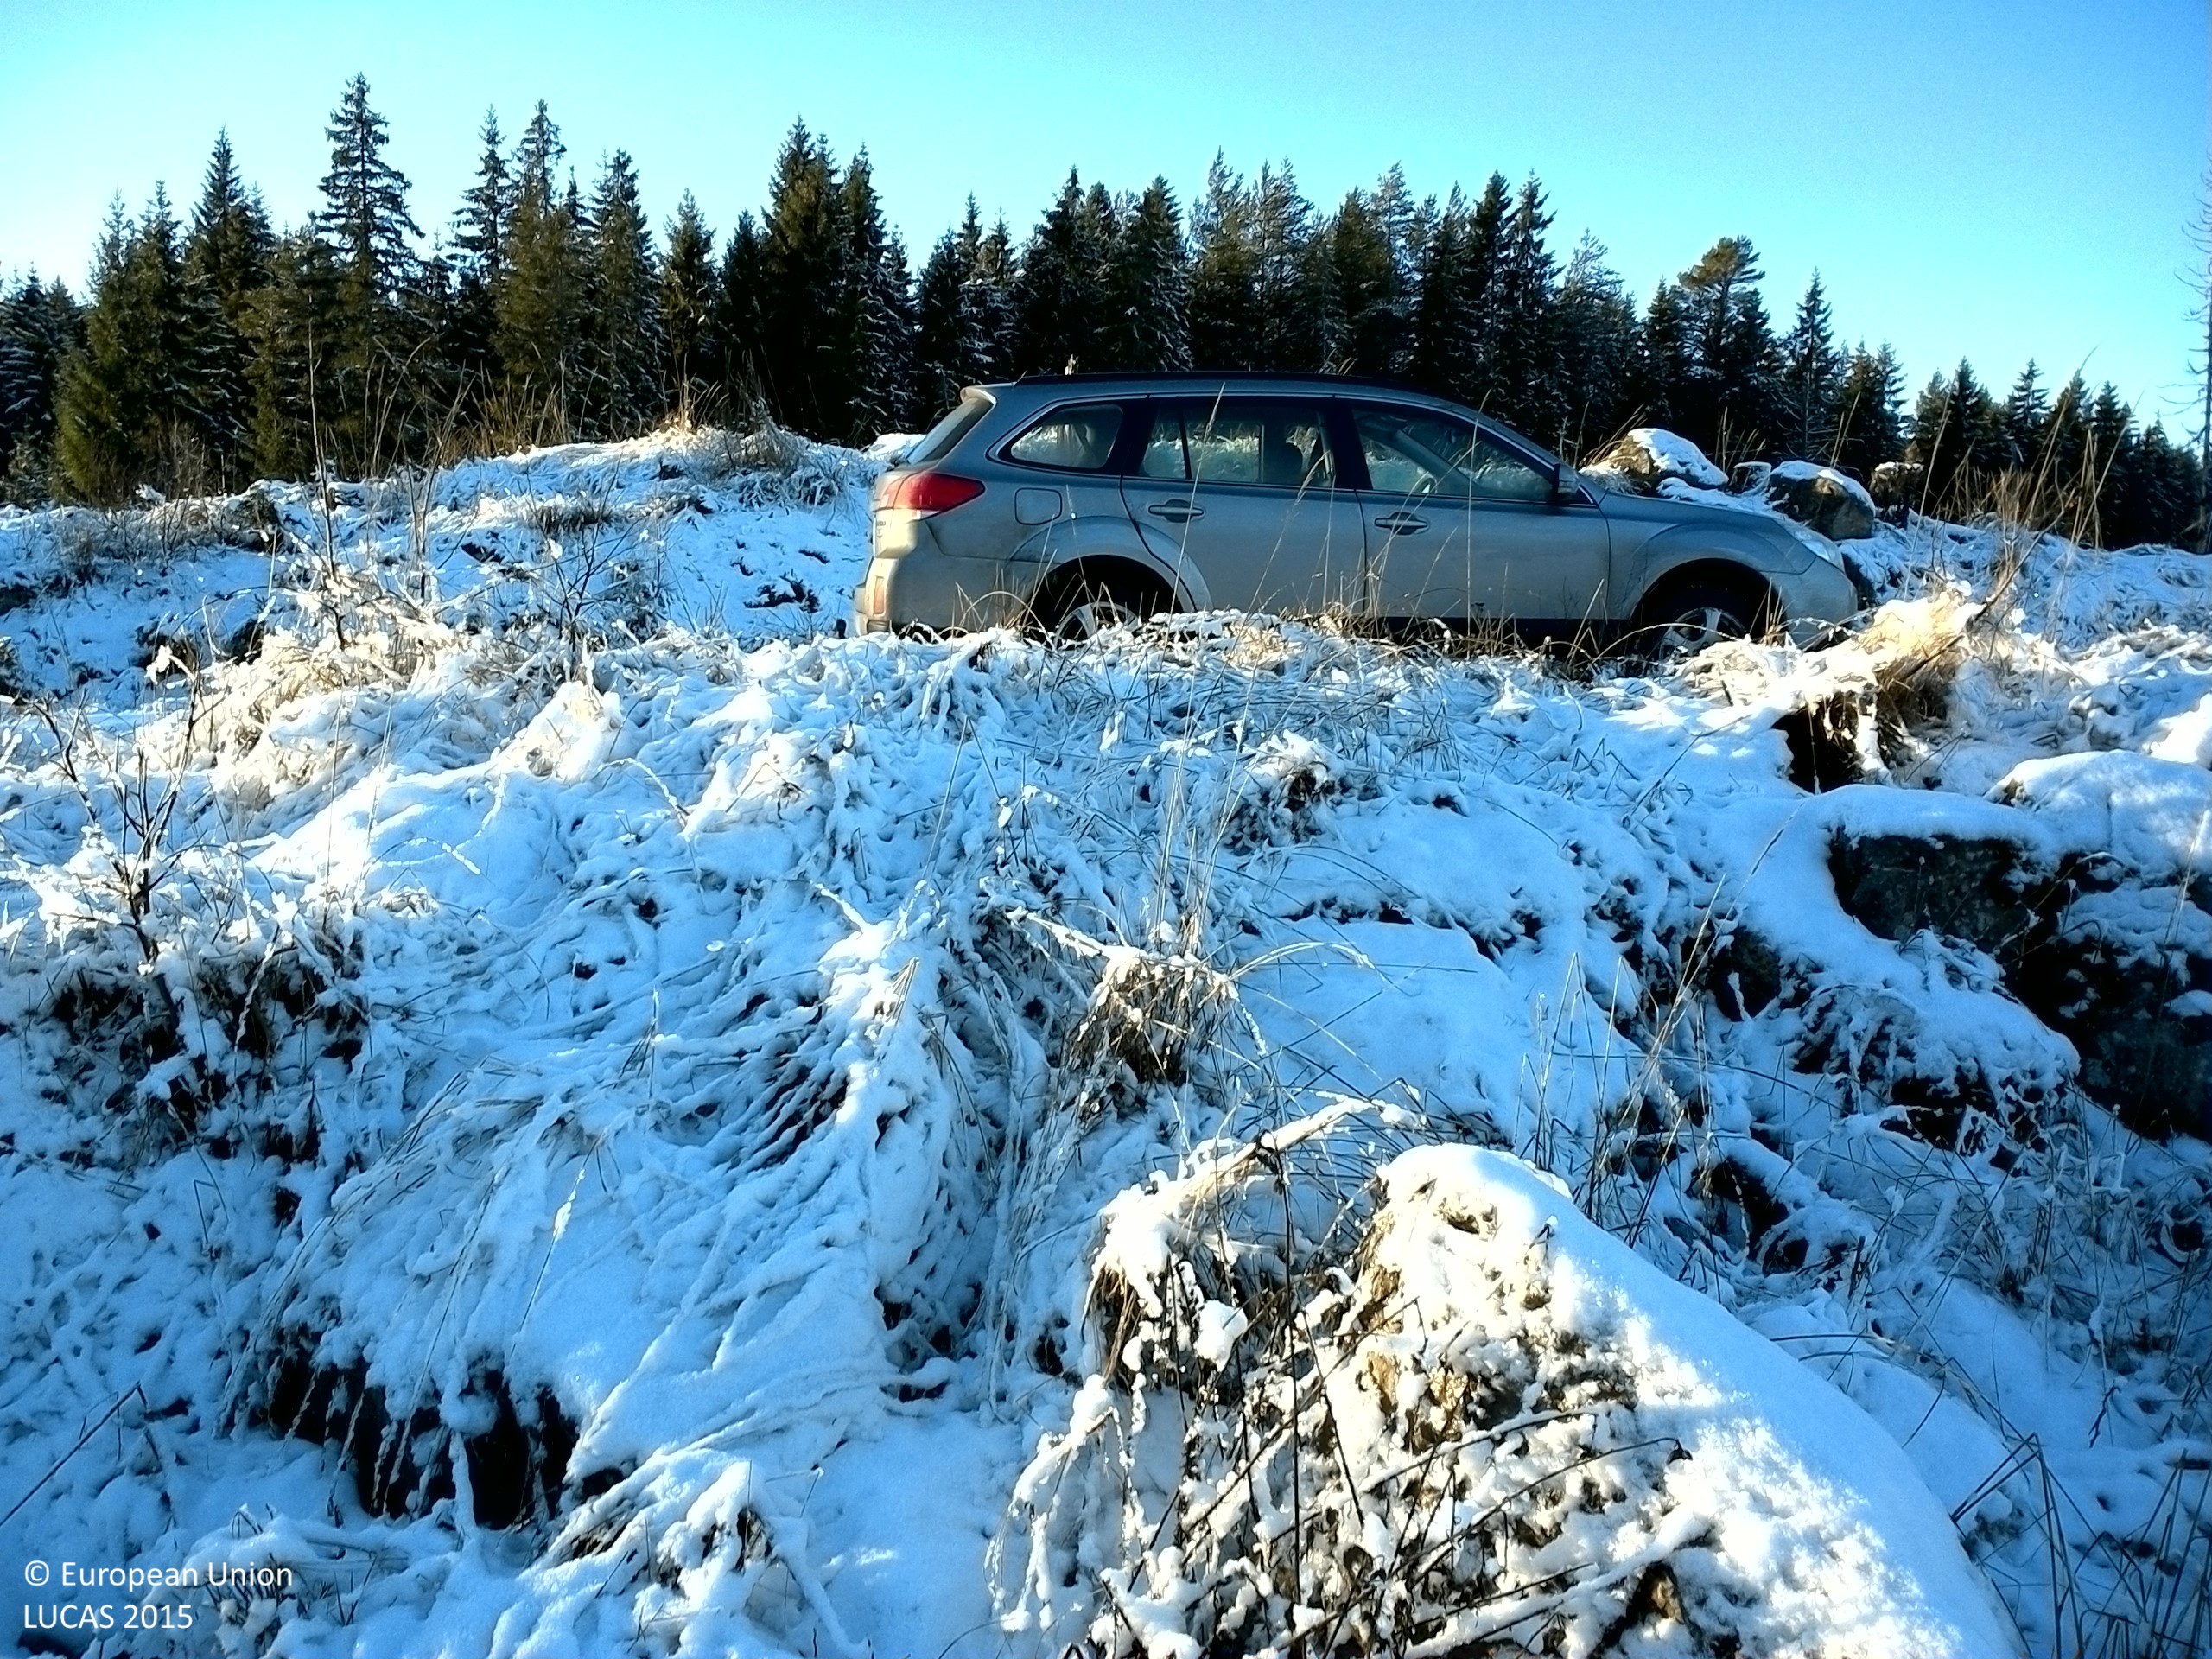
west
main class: Grassland
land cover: Grassland with sparse tree/shrub cover
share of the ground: > 75 %
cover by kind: herbaceous plants 70 %, consolidated bare surface 25 %, broadleaved forest trees 5 %
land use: Forestry
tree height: > 5 m
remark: Clear cut
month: November
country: SE
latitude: 59.6936
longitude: 16.3696
